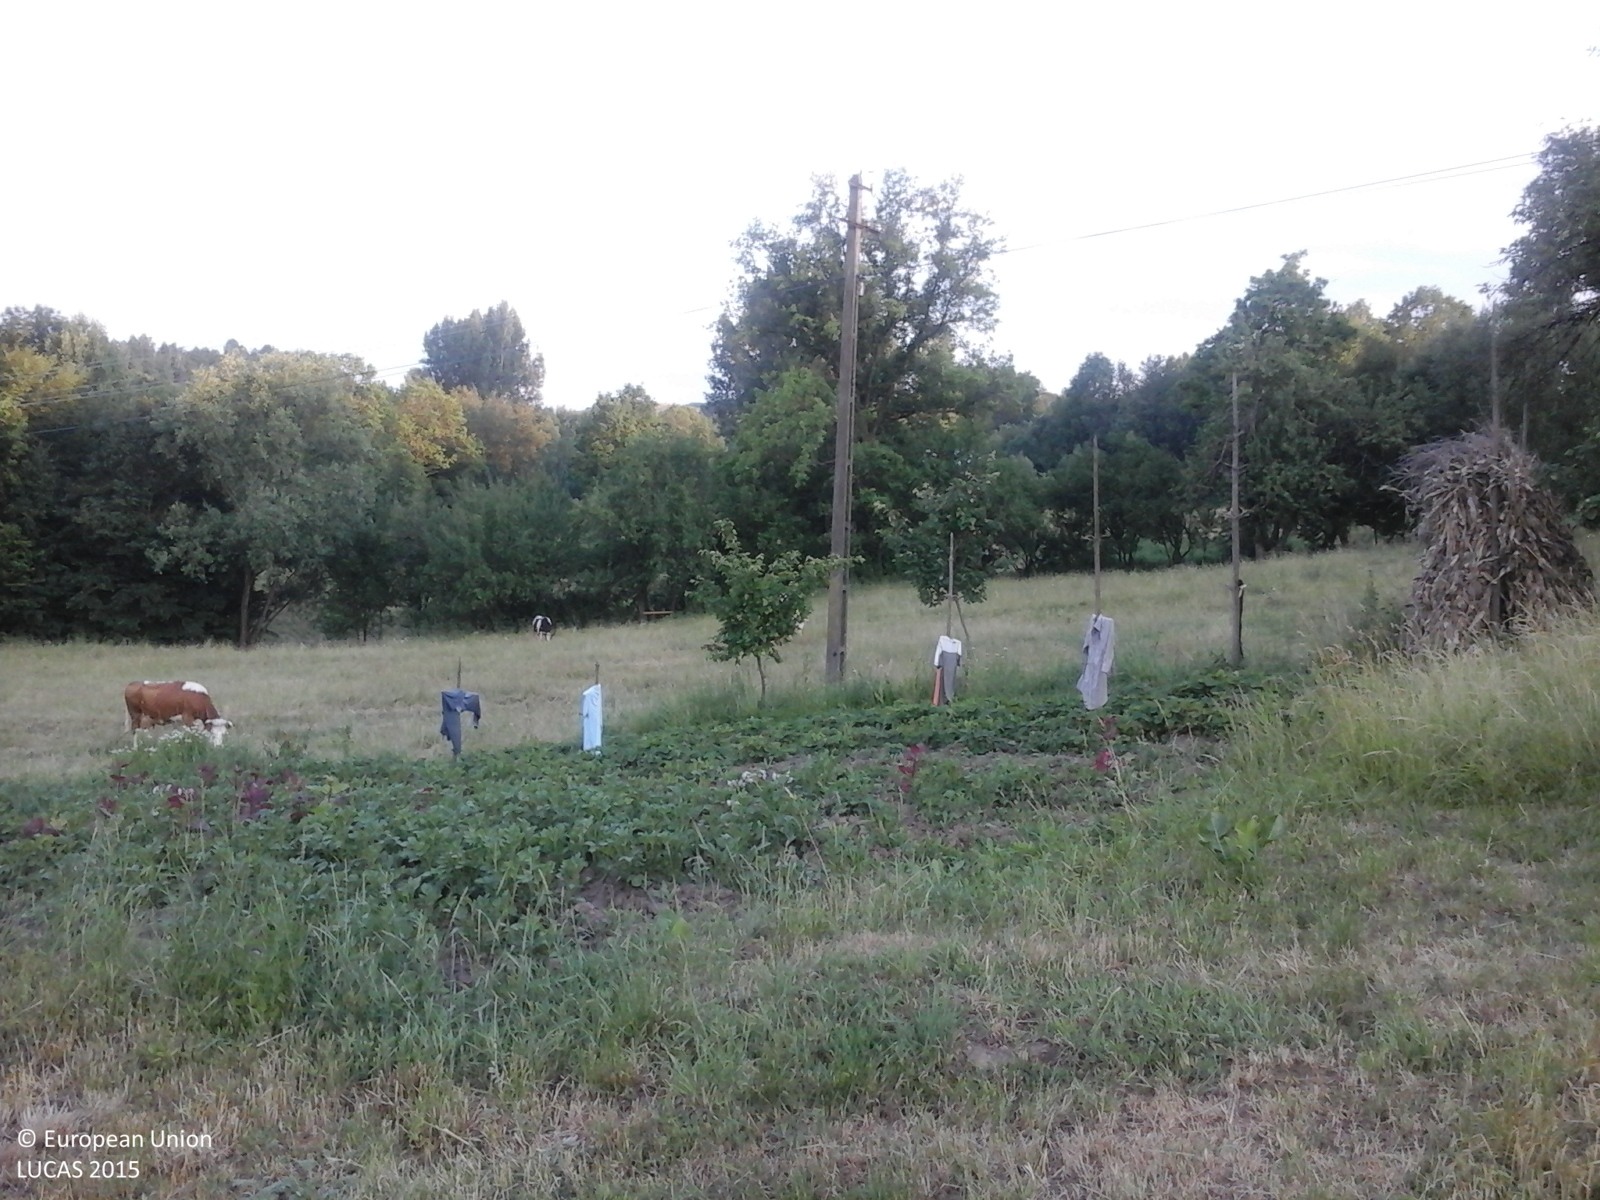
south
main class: Cropland
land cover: Lucerne
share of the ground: 25 - 50 %
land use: Agriculture (excluding fallow land and kitchen gardens)
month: June
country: RO
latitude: 47.6775
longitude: 25.9392
